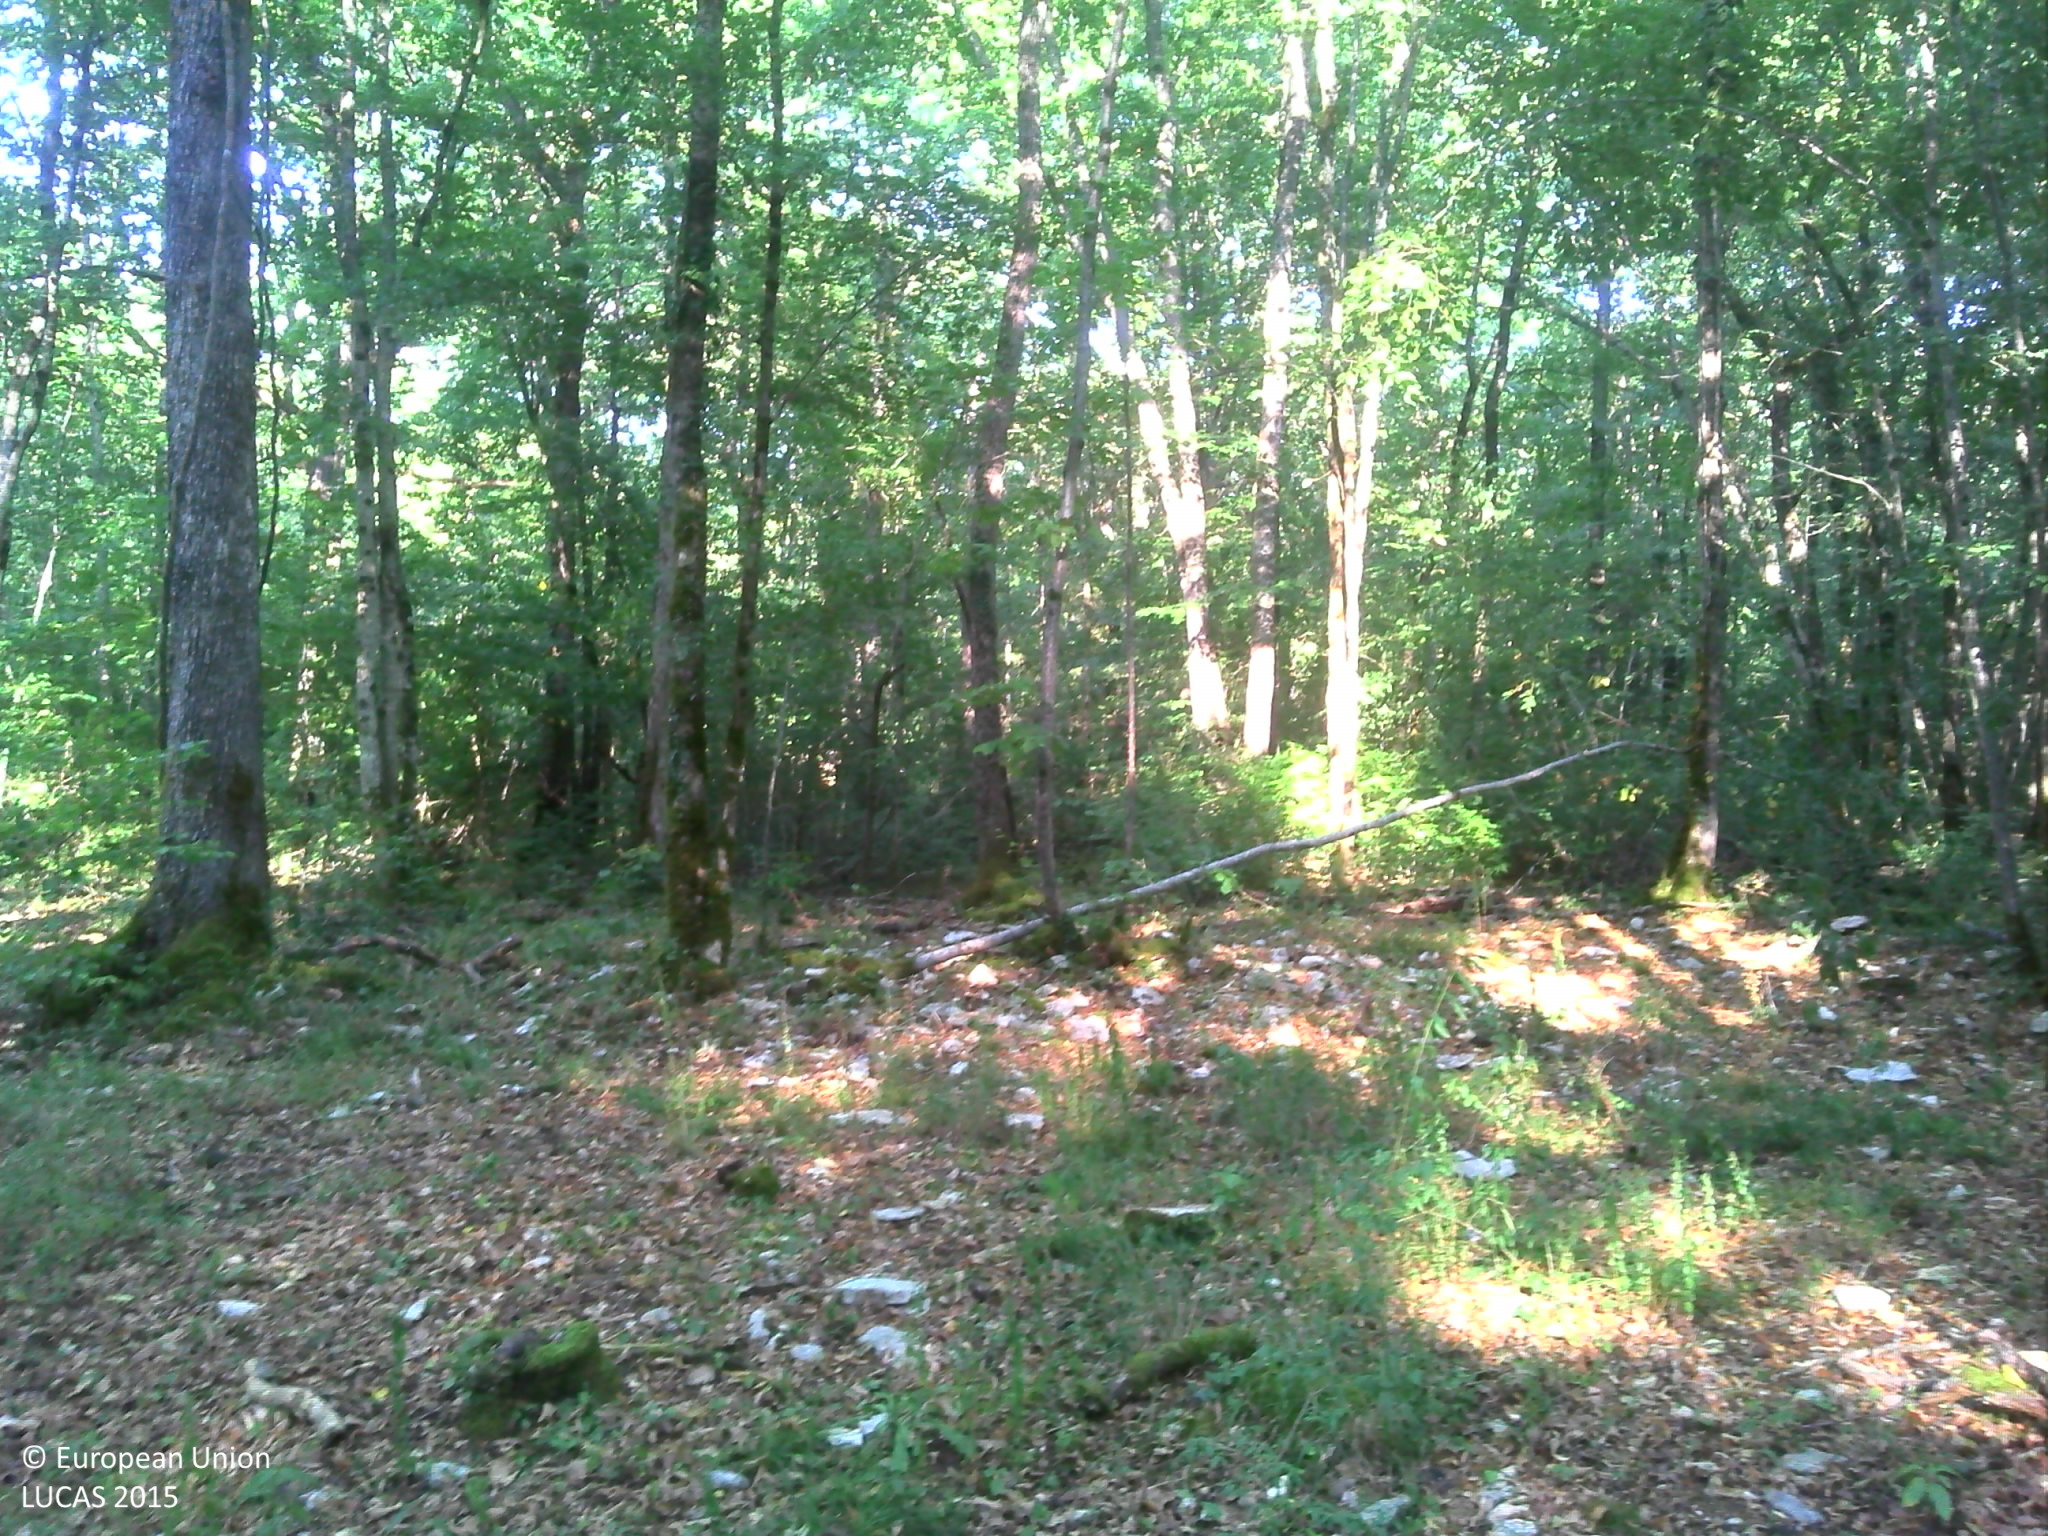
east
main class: Woodland
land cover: Broadleaved woodland
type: acidophilous oak and oak-birch forest
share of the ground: > 75 %
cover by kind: broadleaved forest trees 85 %, lichens and mosses 10 %, herbaceous plants 5 %
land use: Forestry
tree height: > 5 m
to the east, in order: Broadleaved woodland; Tracks; Broadleaved woodland
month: July
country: FR
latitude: 47.8726
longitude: 4.9321
